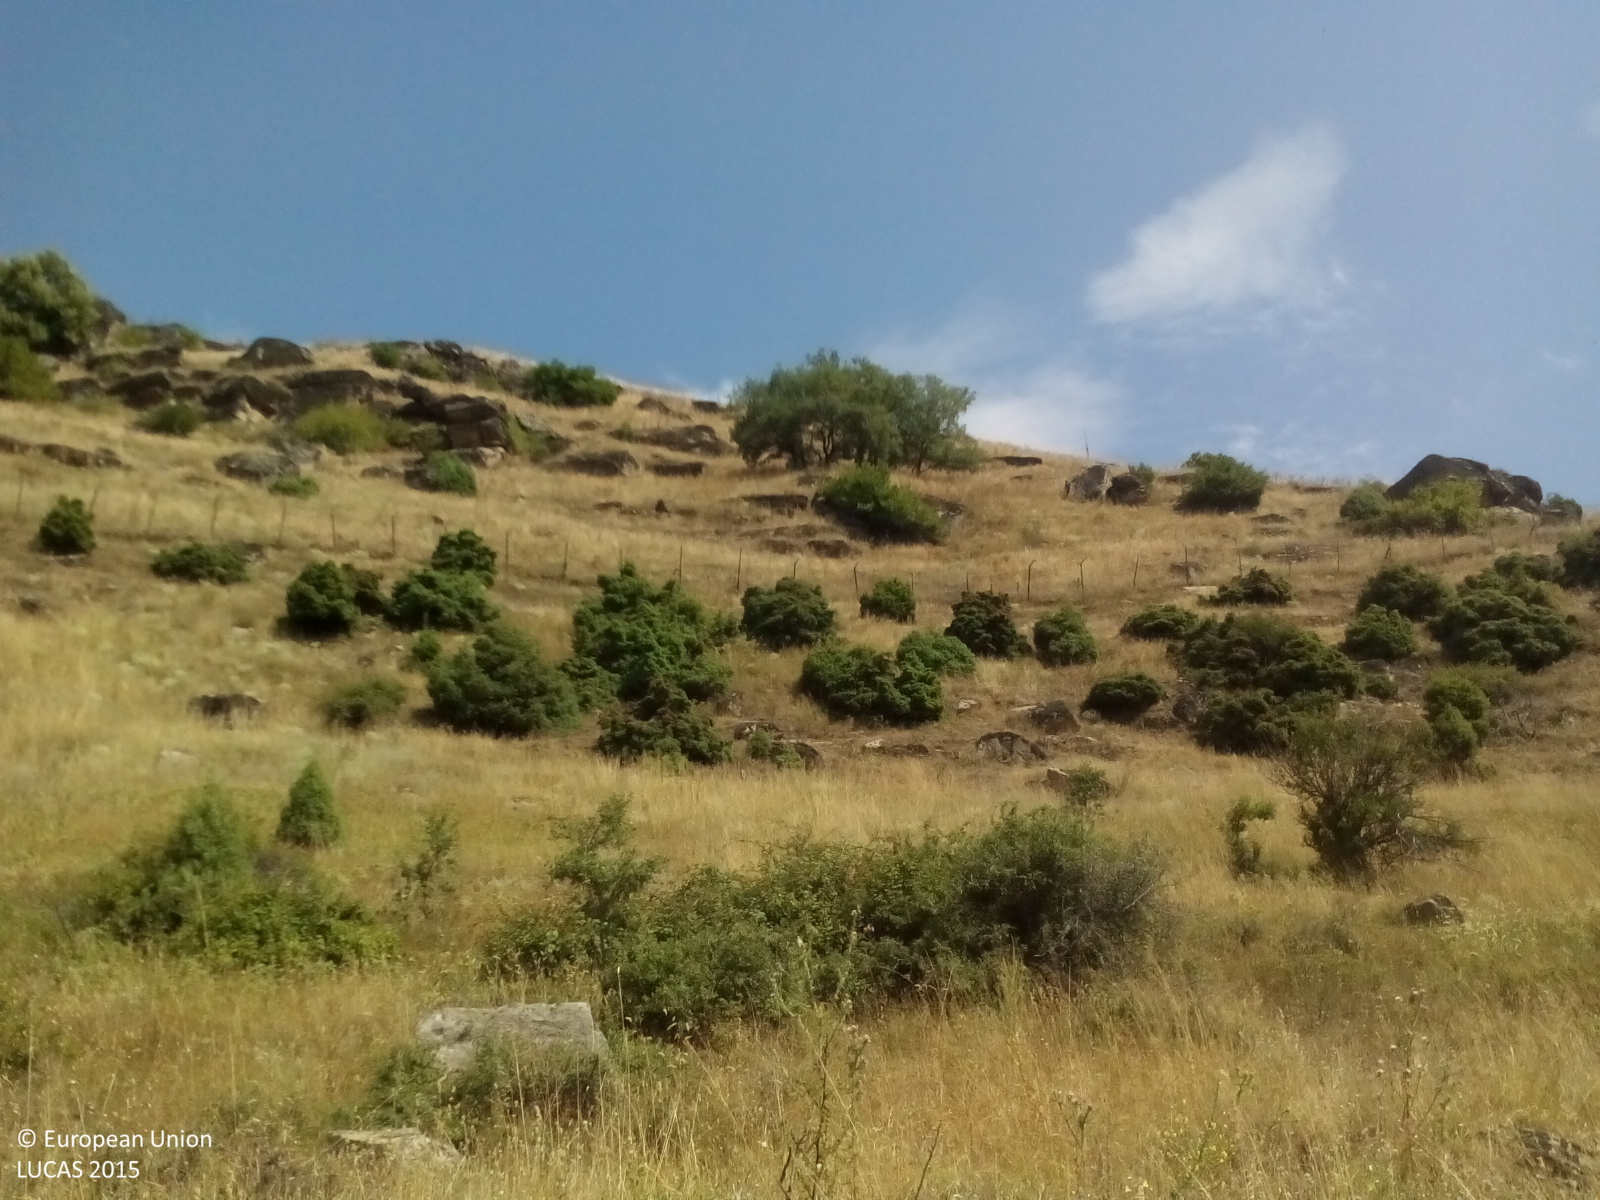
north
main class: Grassland
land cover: Grassland with sparse tree/shrub cover
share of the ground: > 75 %
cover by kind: herbaceous plants 85 %, shrubs 10 %, coniferous forest trees 5 %
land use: Semi-natural and natural areas not in use
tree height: < 5 m
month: August
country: GR
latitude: 40.7682
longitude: 21.4023
